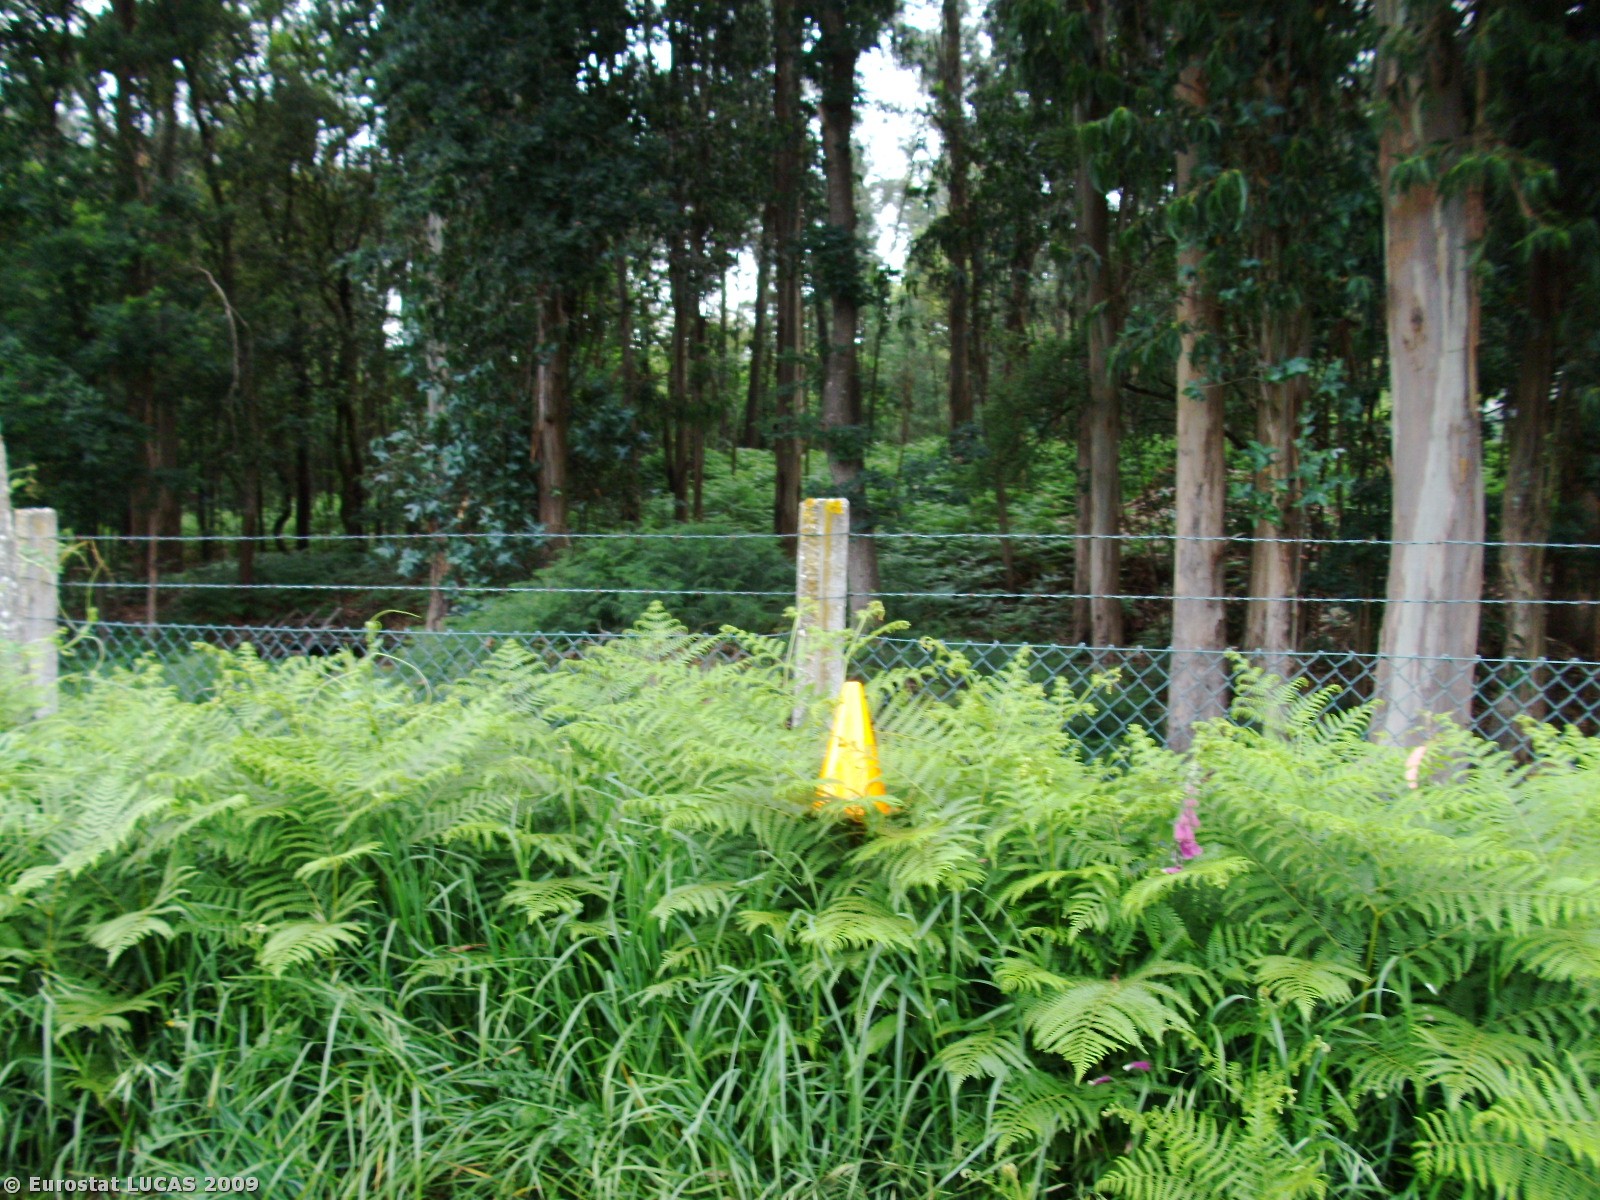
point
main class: Woodland
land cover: Broadleaved woodland
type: plantations and self-sown exotic forest
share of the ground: > 75 %
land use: Forestry
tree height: > 5 m
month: May
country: PT
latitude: 41.0904
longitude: -8.5424
